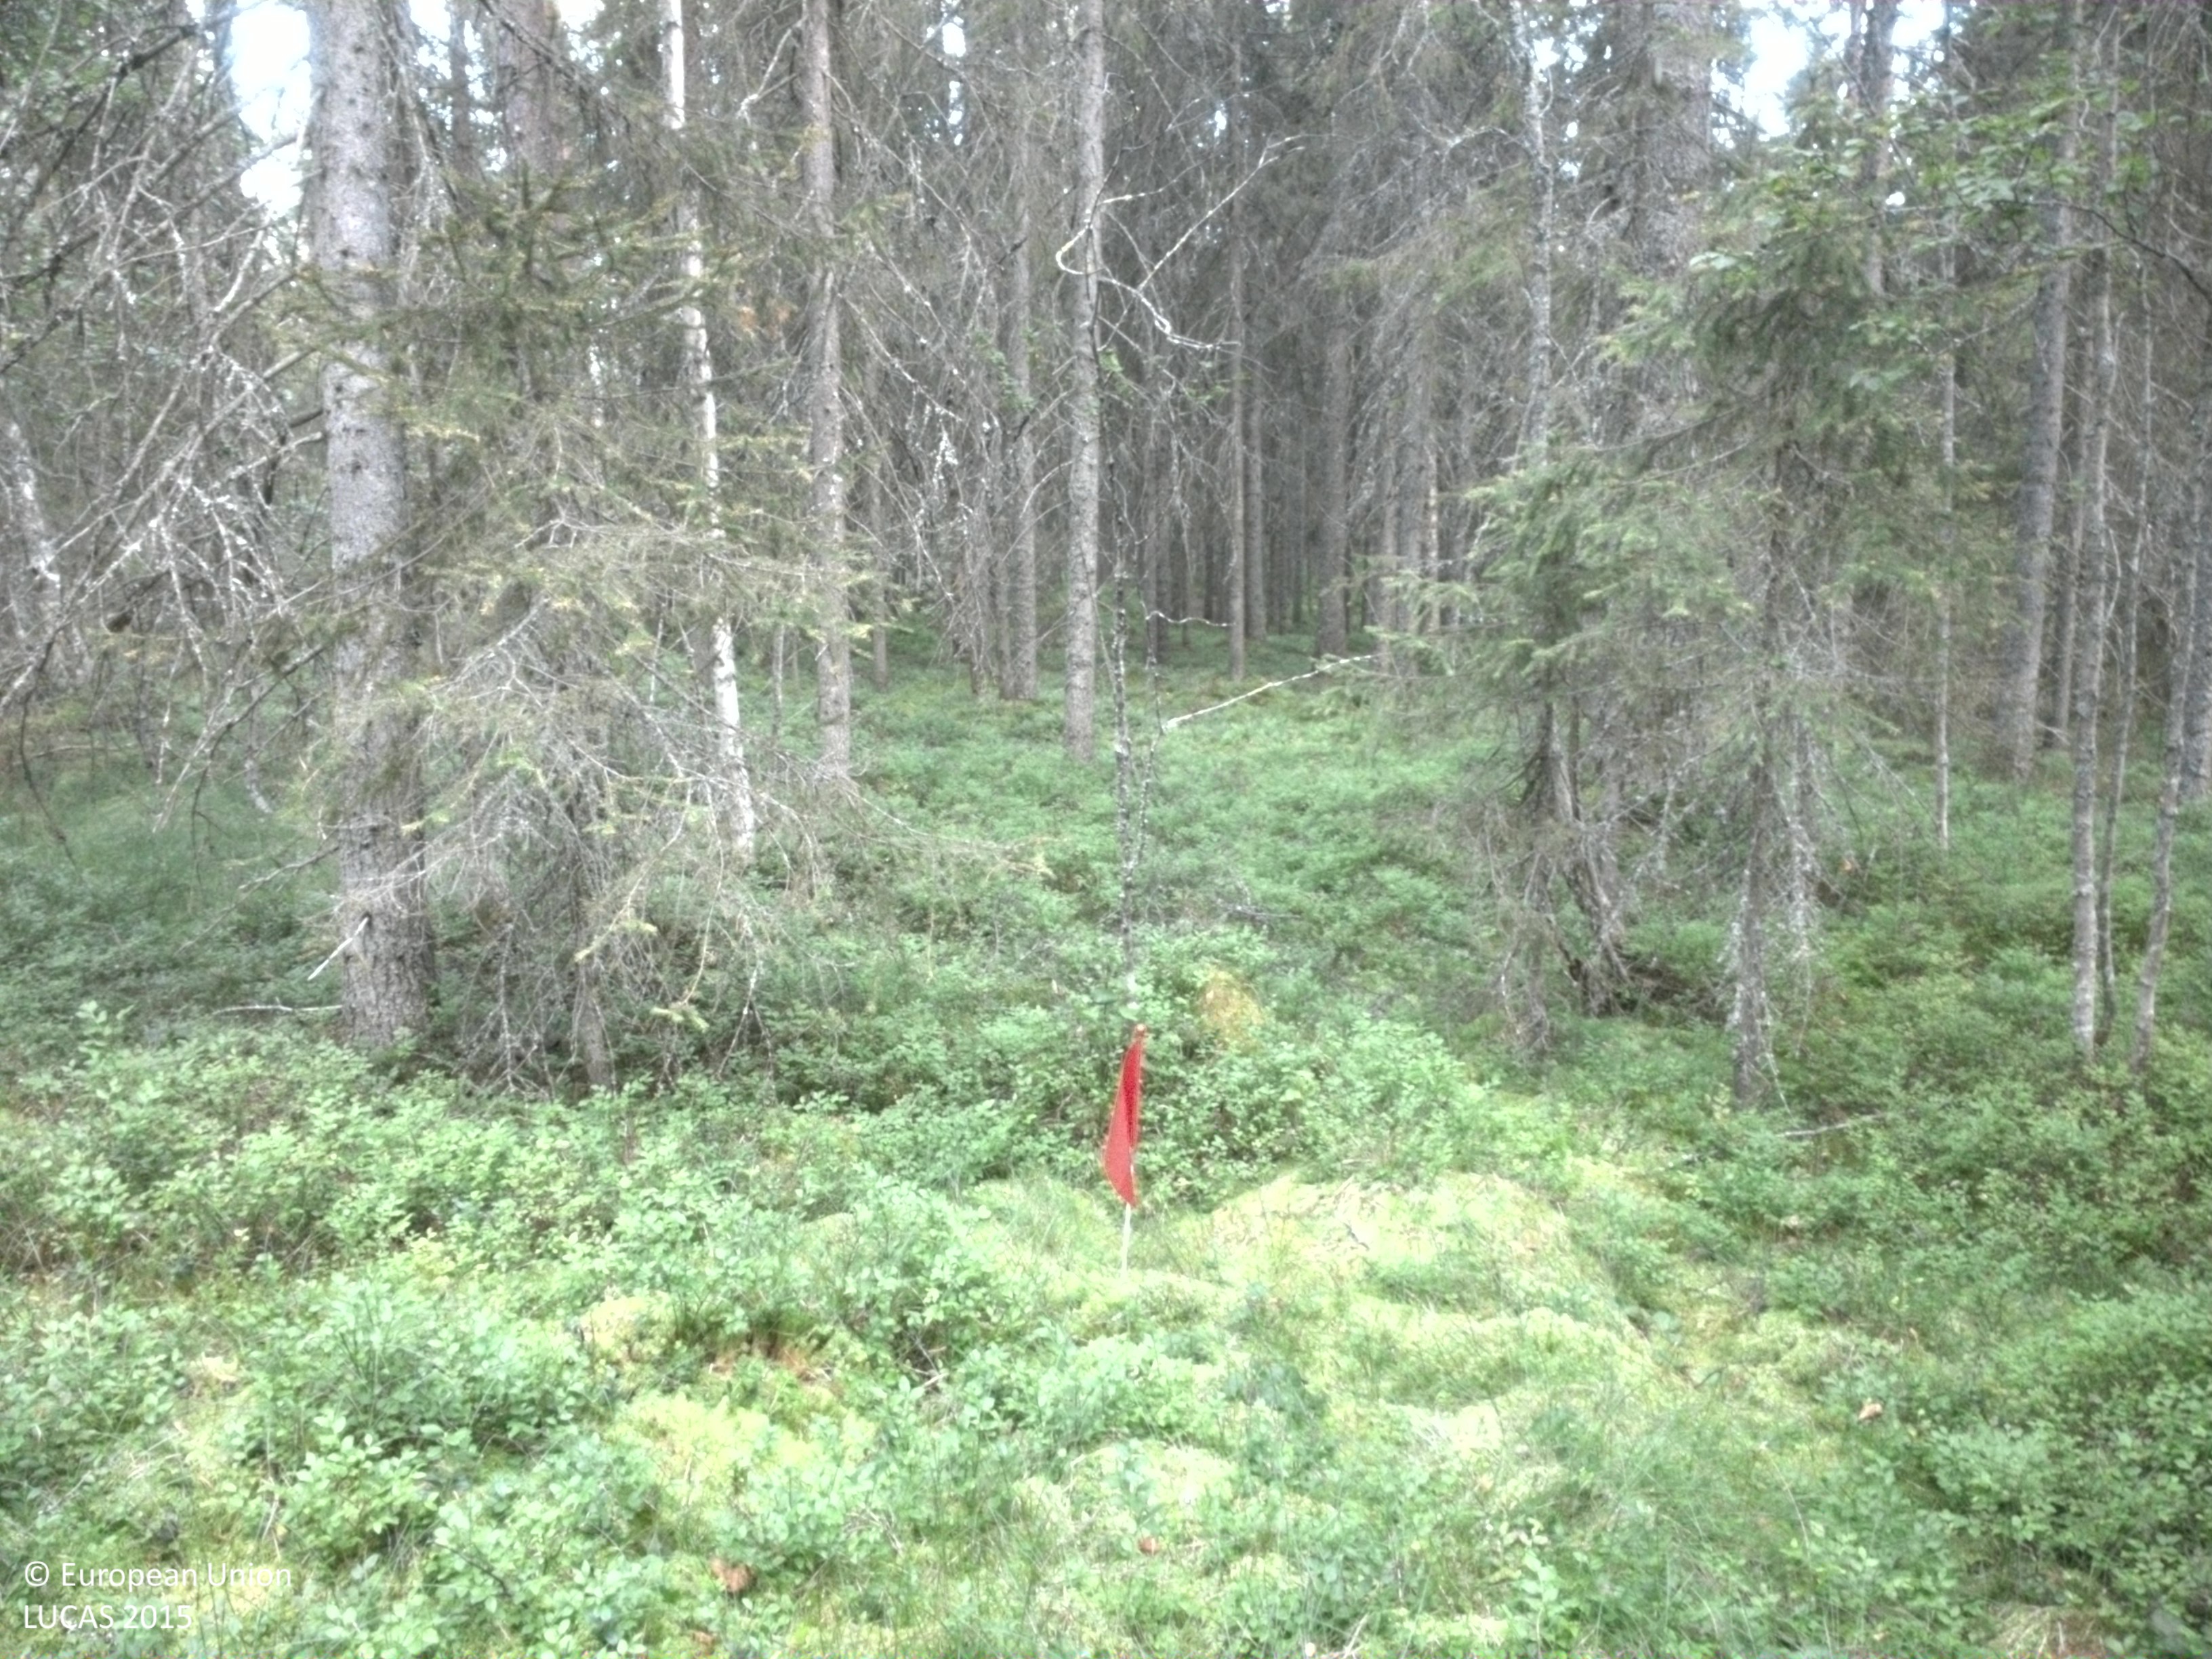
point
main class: Woodland
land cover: Spruce dominated coniferous woodland
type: boreal forest
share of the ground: 50 - 75 %
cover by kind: coniferous forest trees 70 %, shrubs 25 %, lichens and mosses 5 %
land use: Forestry
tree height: > 5 m
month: August
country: SE
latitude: 64.2458
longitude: 20.5618
